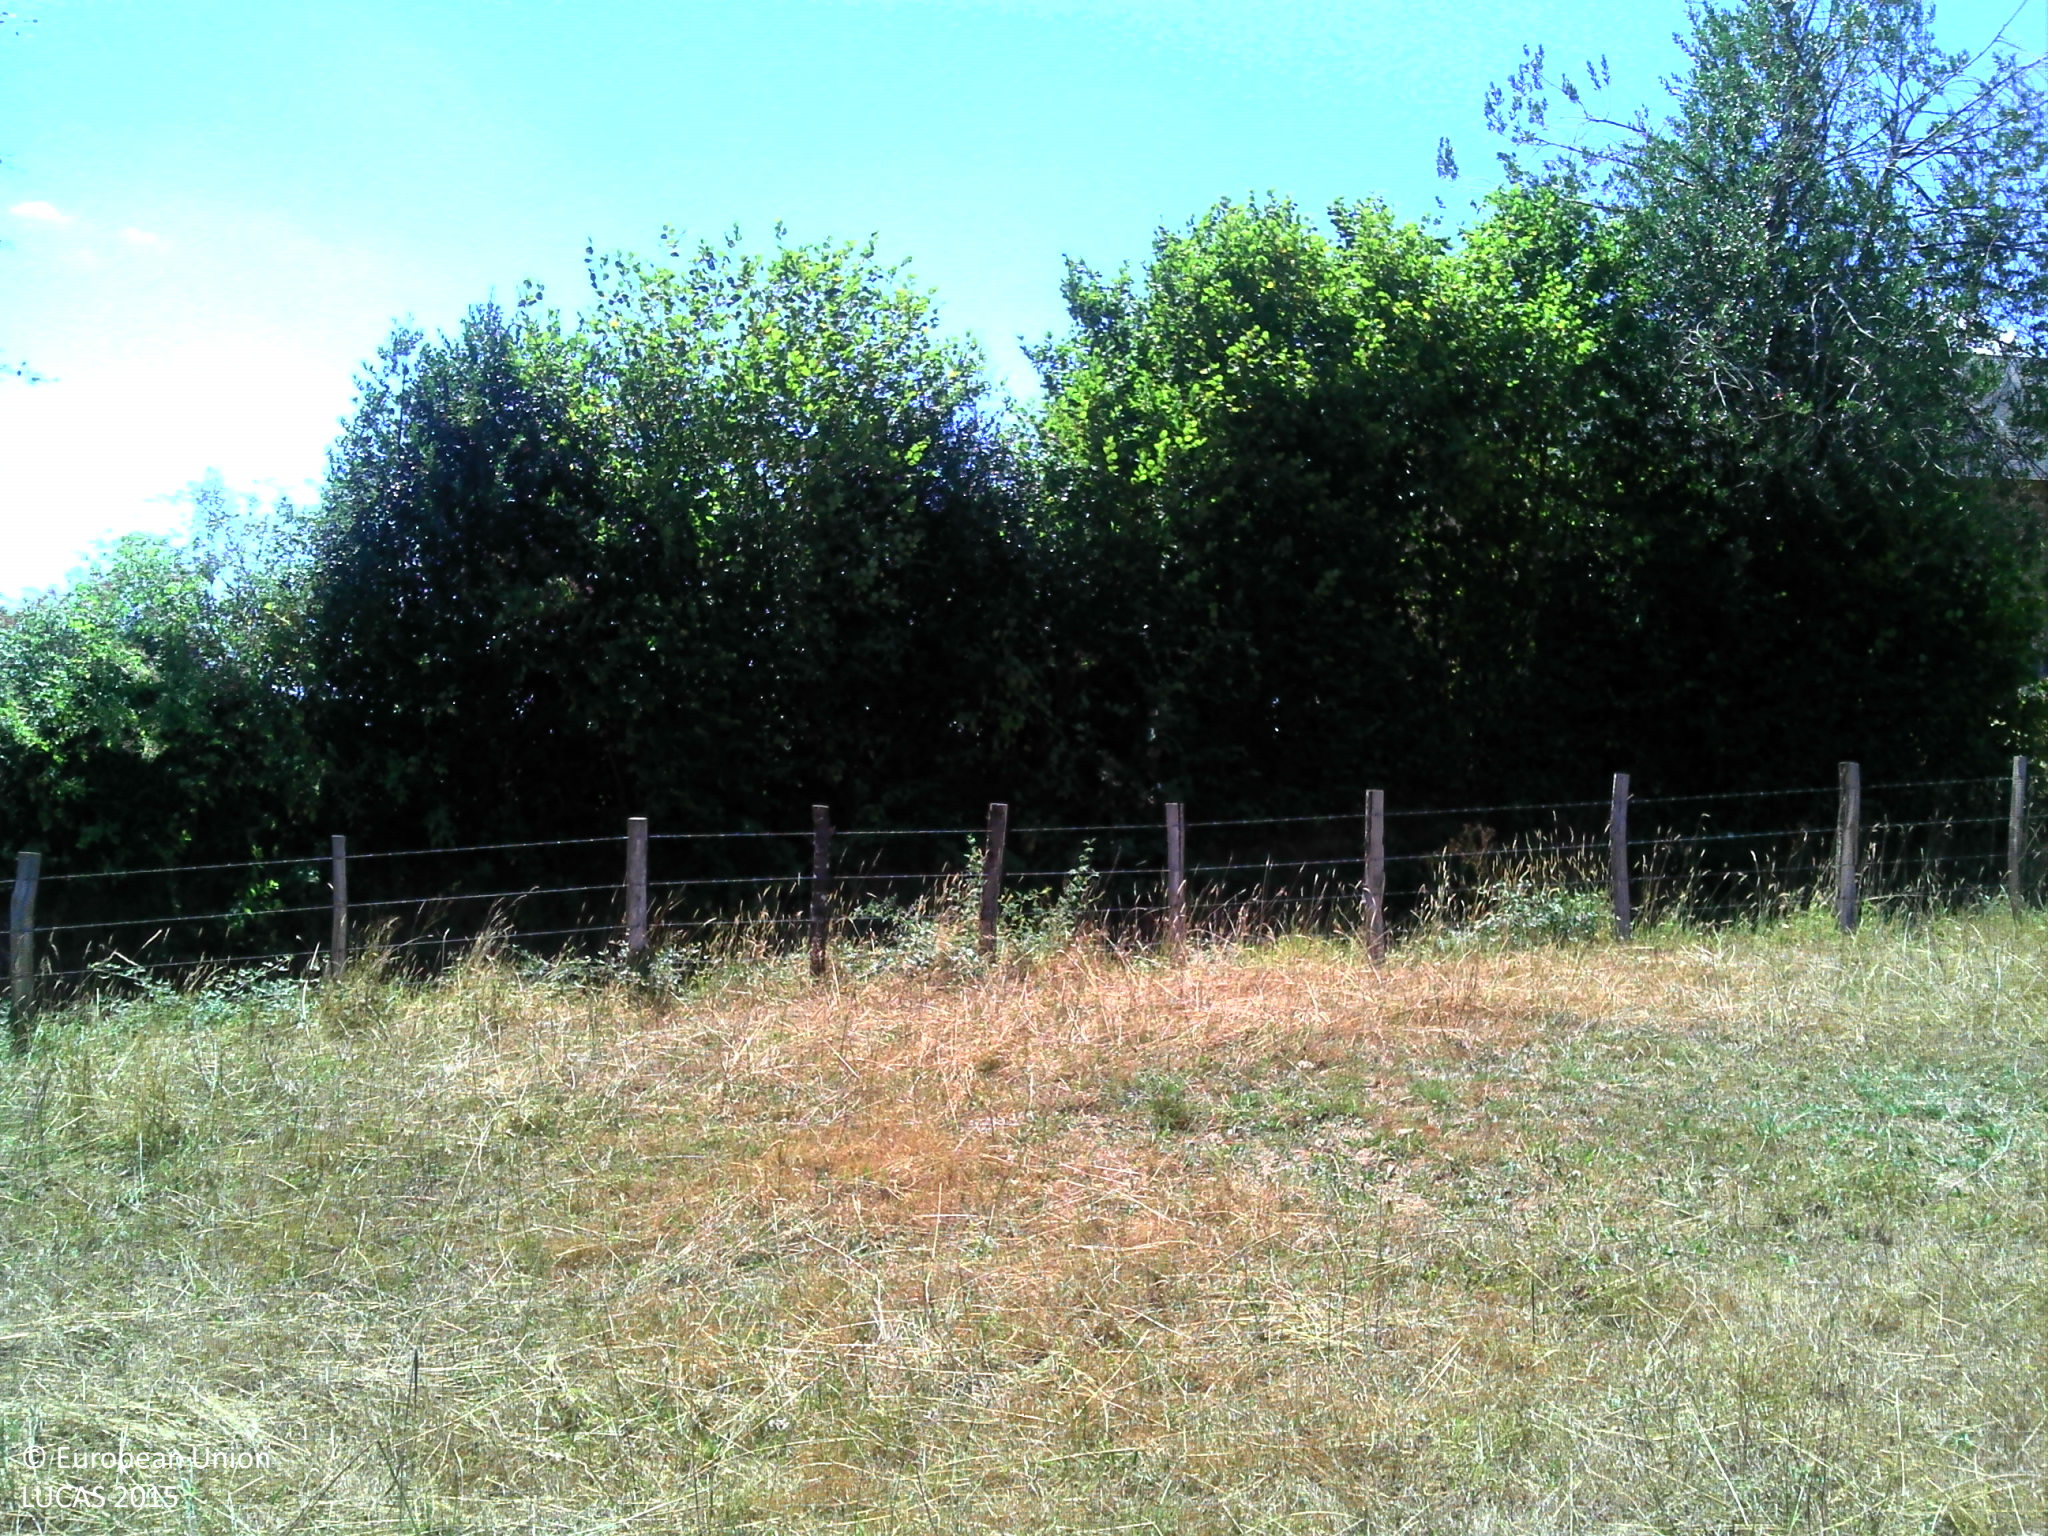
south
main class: Grassland
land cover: Grassland without tree/shrub cover
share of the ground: > 75 %
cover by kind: herbaceous plants 100 %
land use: Agriculture (excluding fallow land and kitchen gardens)
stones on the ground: < 10 %
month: July
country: FR
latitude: 45.5718
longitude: 1.6523
